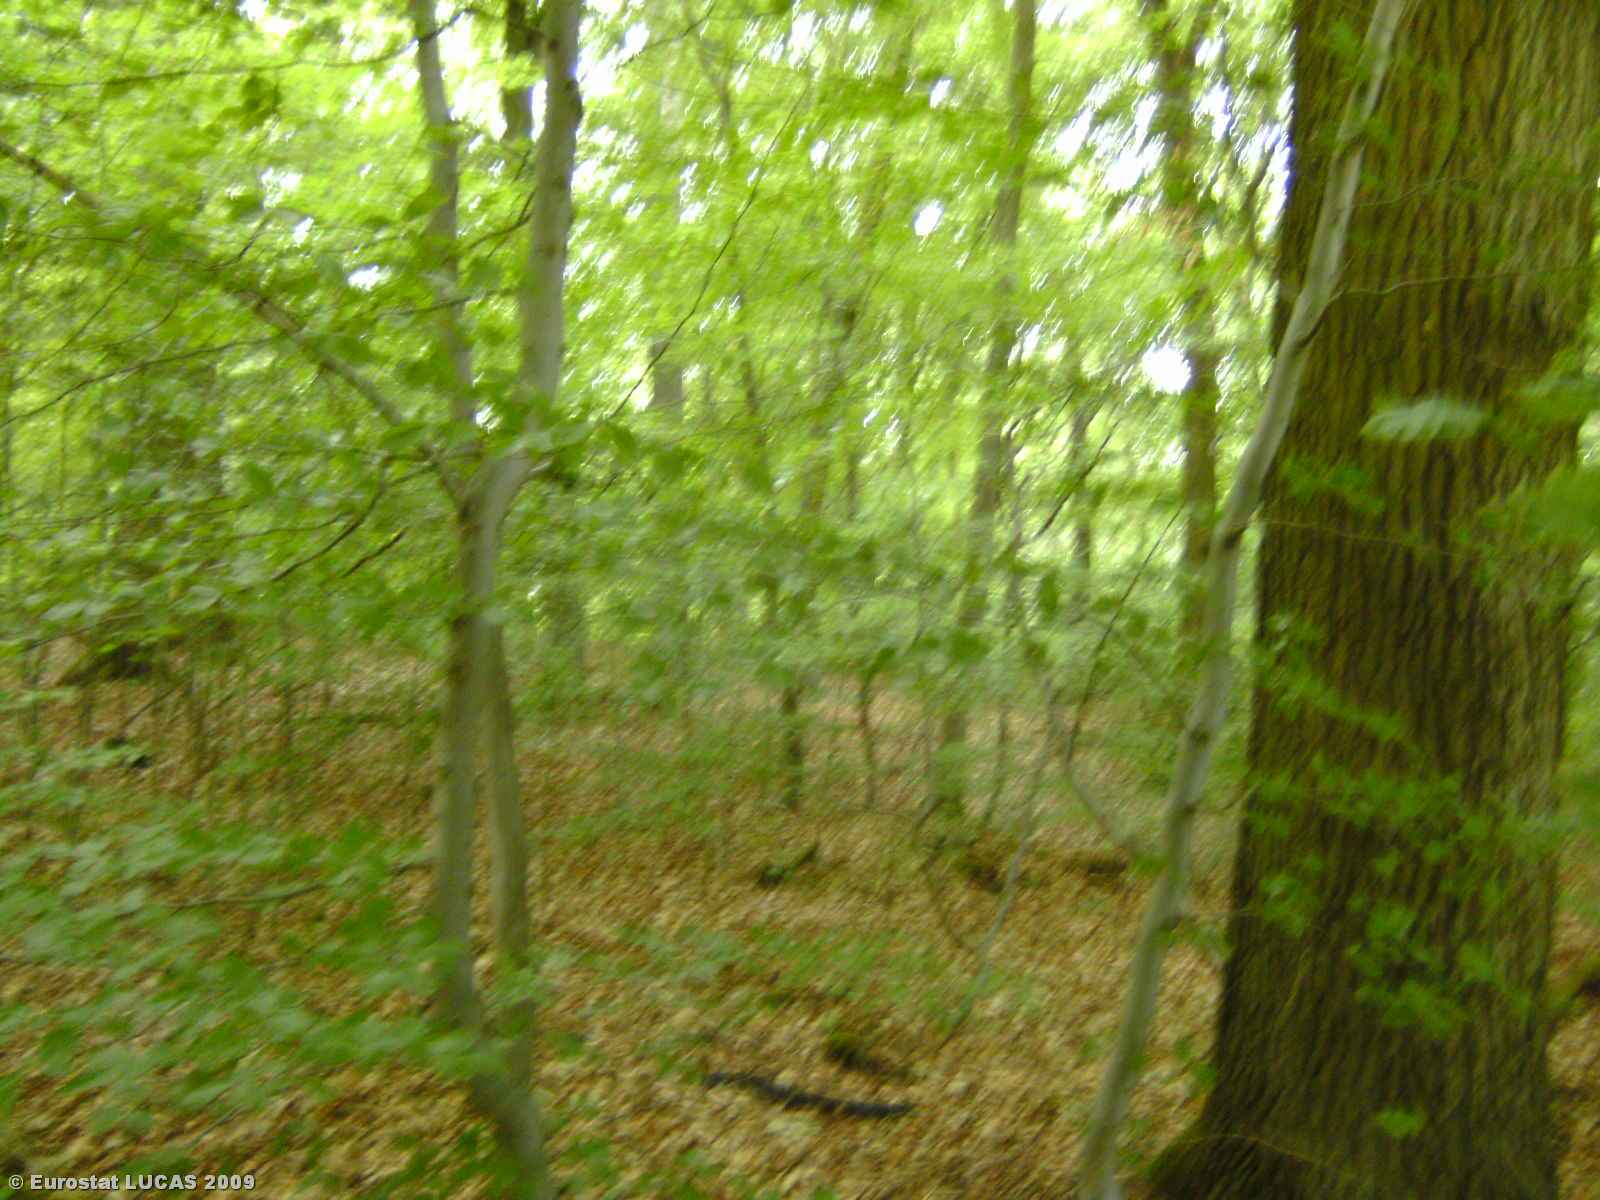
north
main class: Woodland
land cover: Broadleaved woodland
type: mesophytic deciduous forest
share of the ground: > 75 %
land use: Forestry
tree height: > 5 m
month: June
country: LU
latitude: 49.6032
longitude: 6.3328
